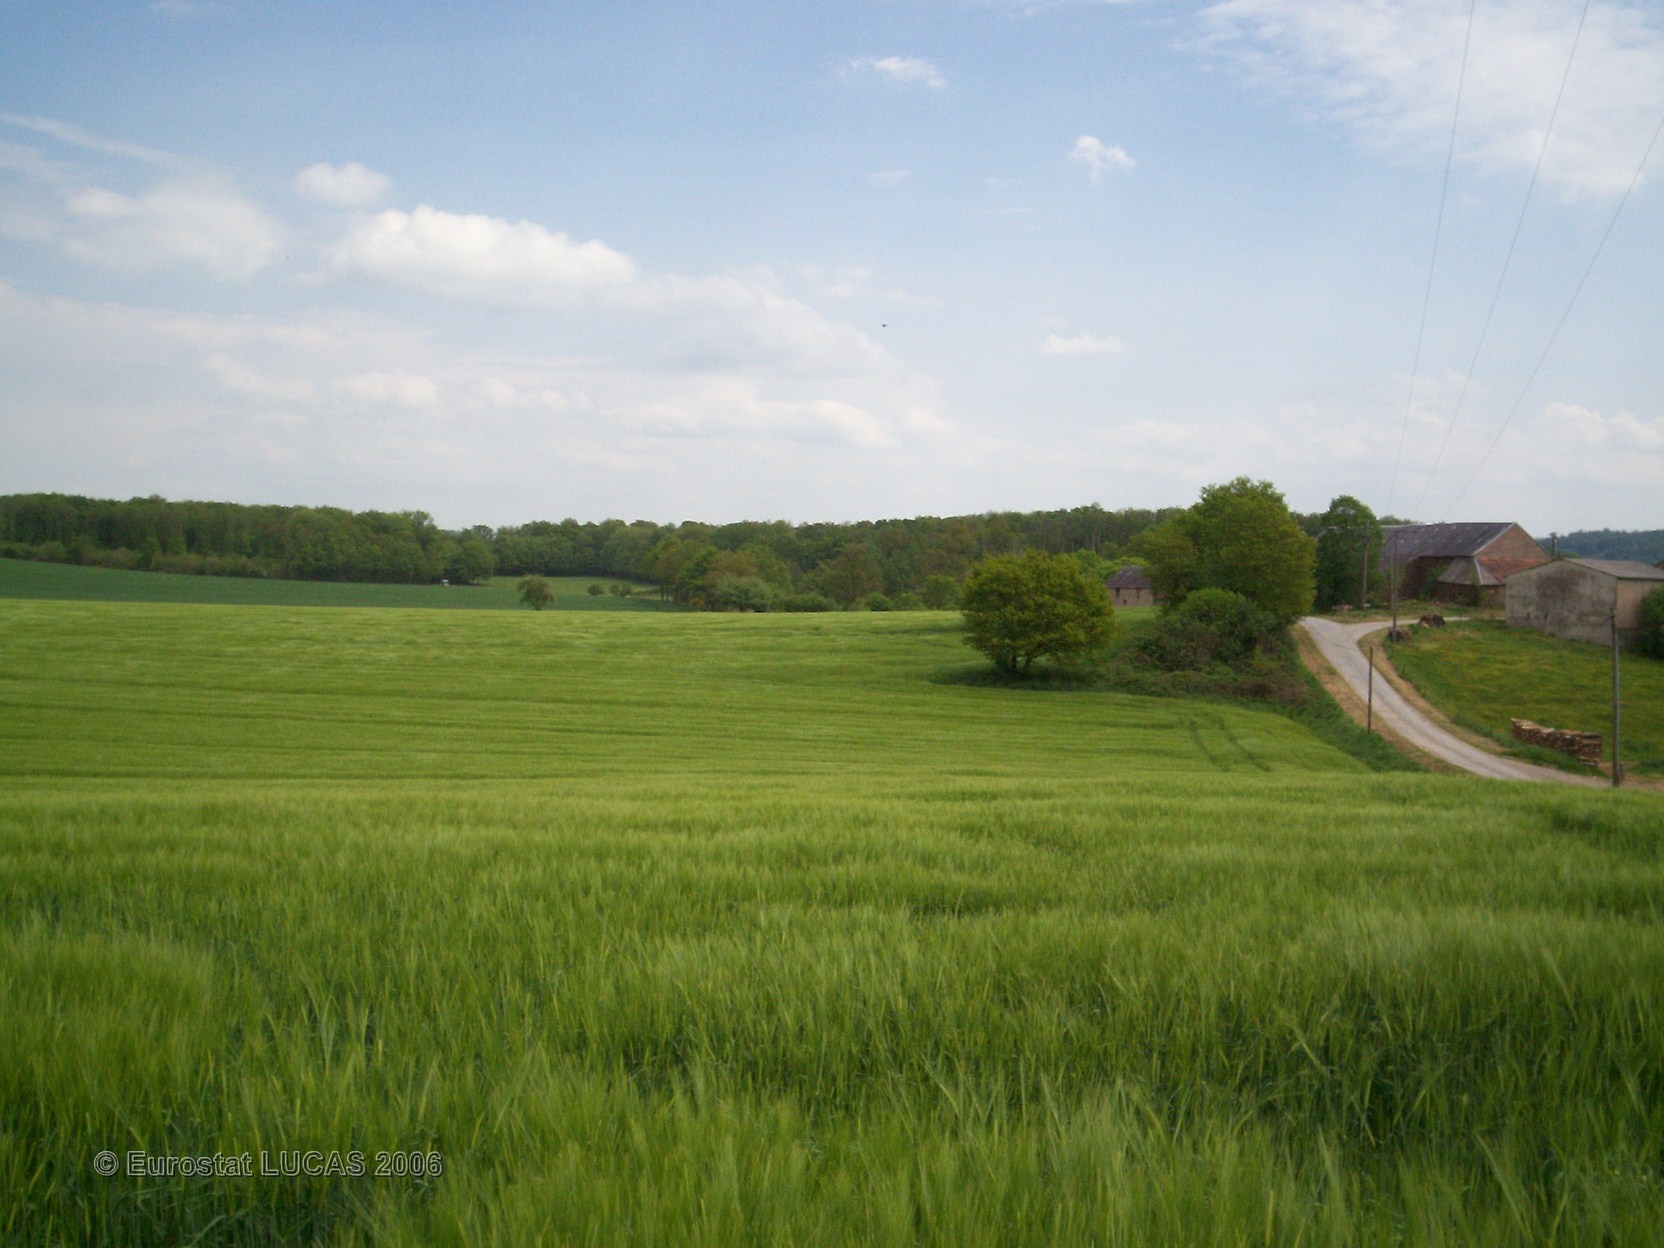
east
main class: Cropland
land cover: Barley
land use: Agriculture (excluding fallow land and kitchen gardens)
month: May
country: FR
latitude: 46.1023
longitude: 1.4920
